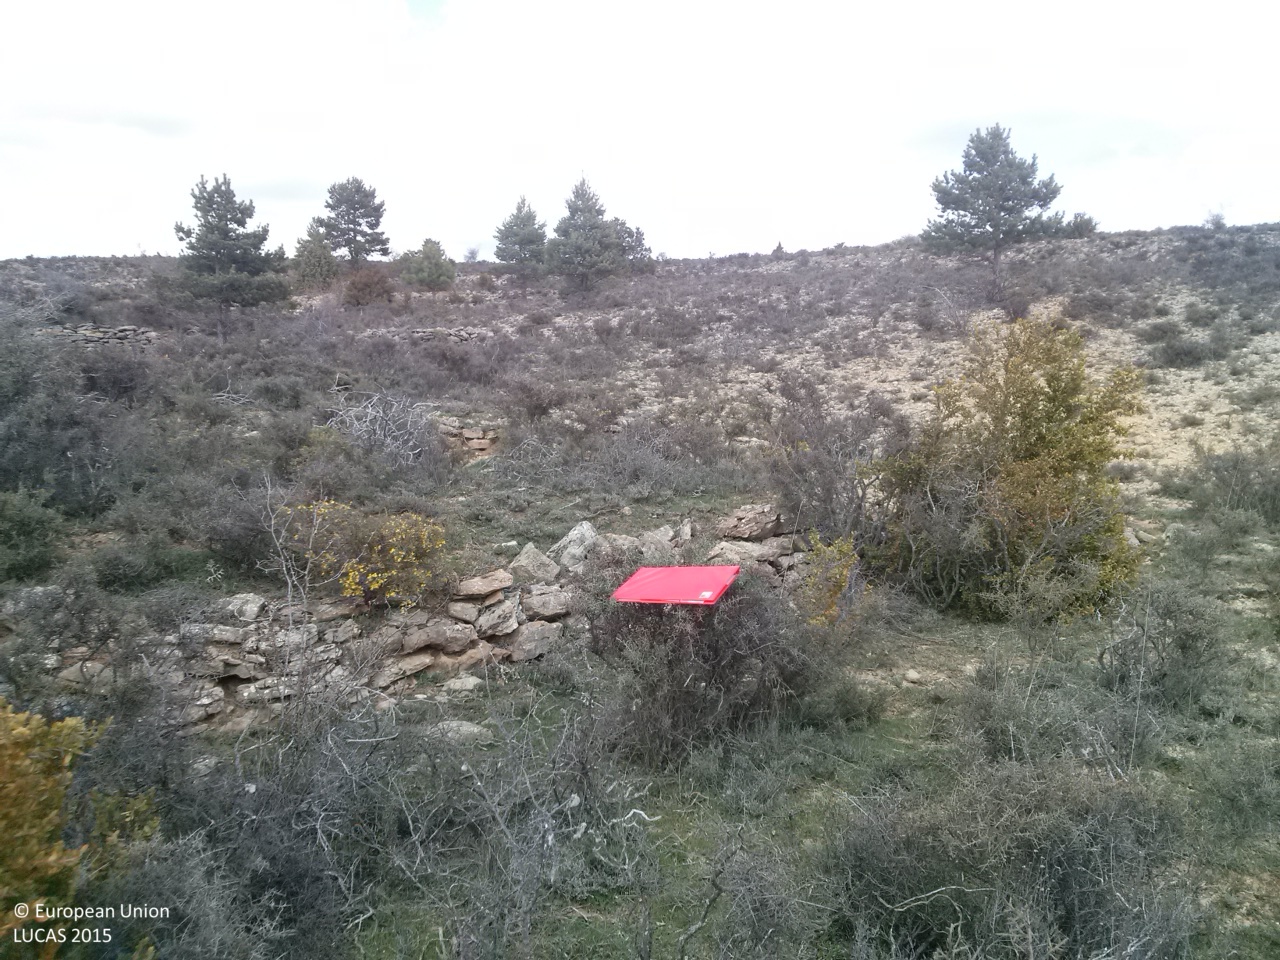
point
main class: Shrubland
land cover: Shrubland without tree cover
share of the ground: > 75 %
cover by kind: shrubs 80 %, herbaceous plants 20 %
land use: Agriculture (excluding fallow land and kitchen gardens)
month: April
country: ES
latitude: 40.1733
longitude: -1.6501
